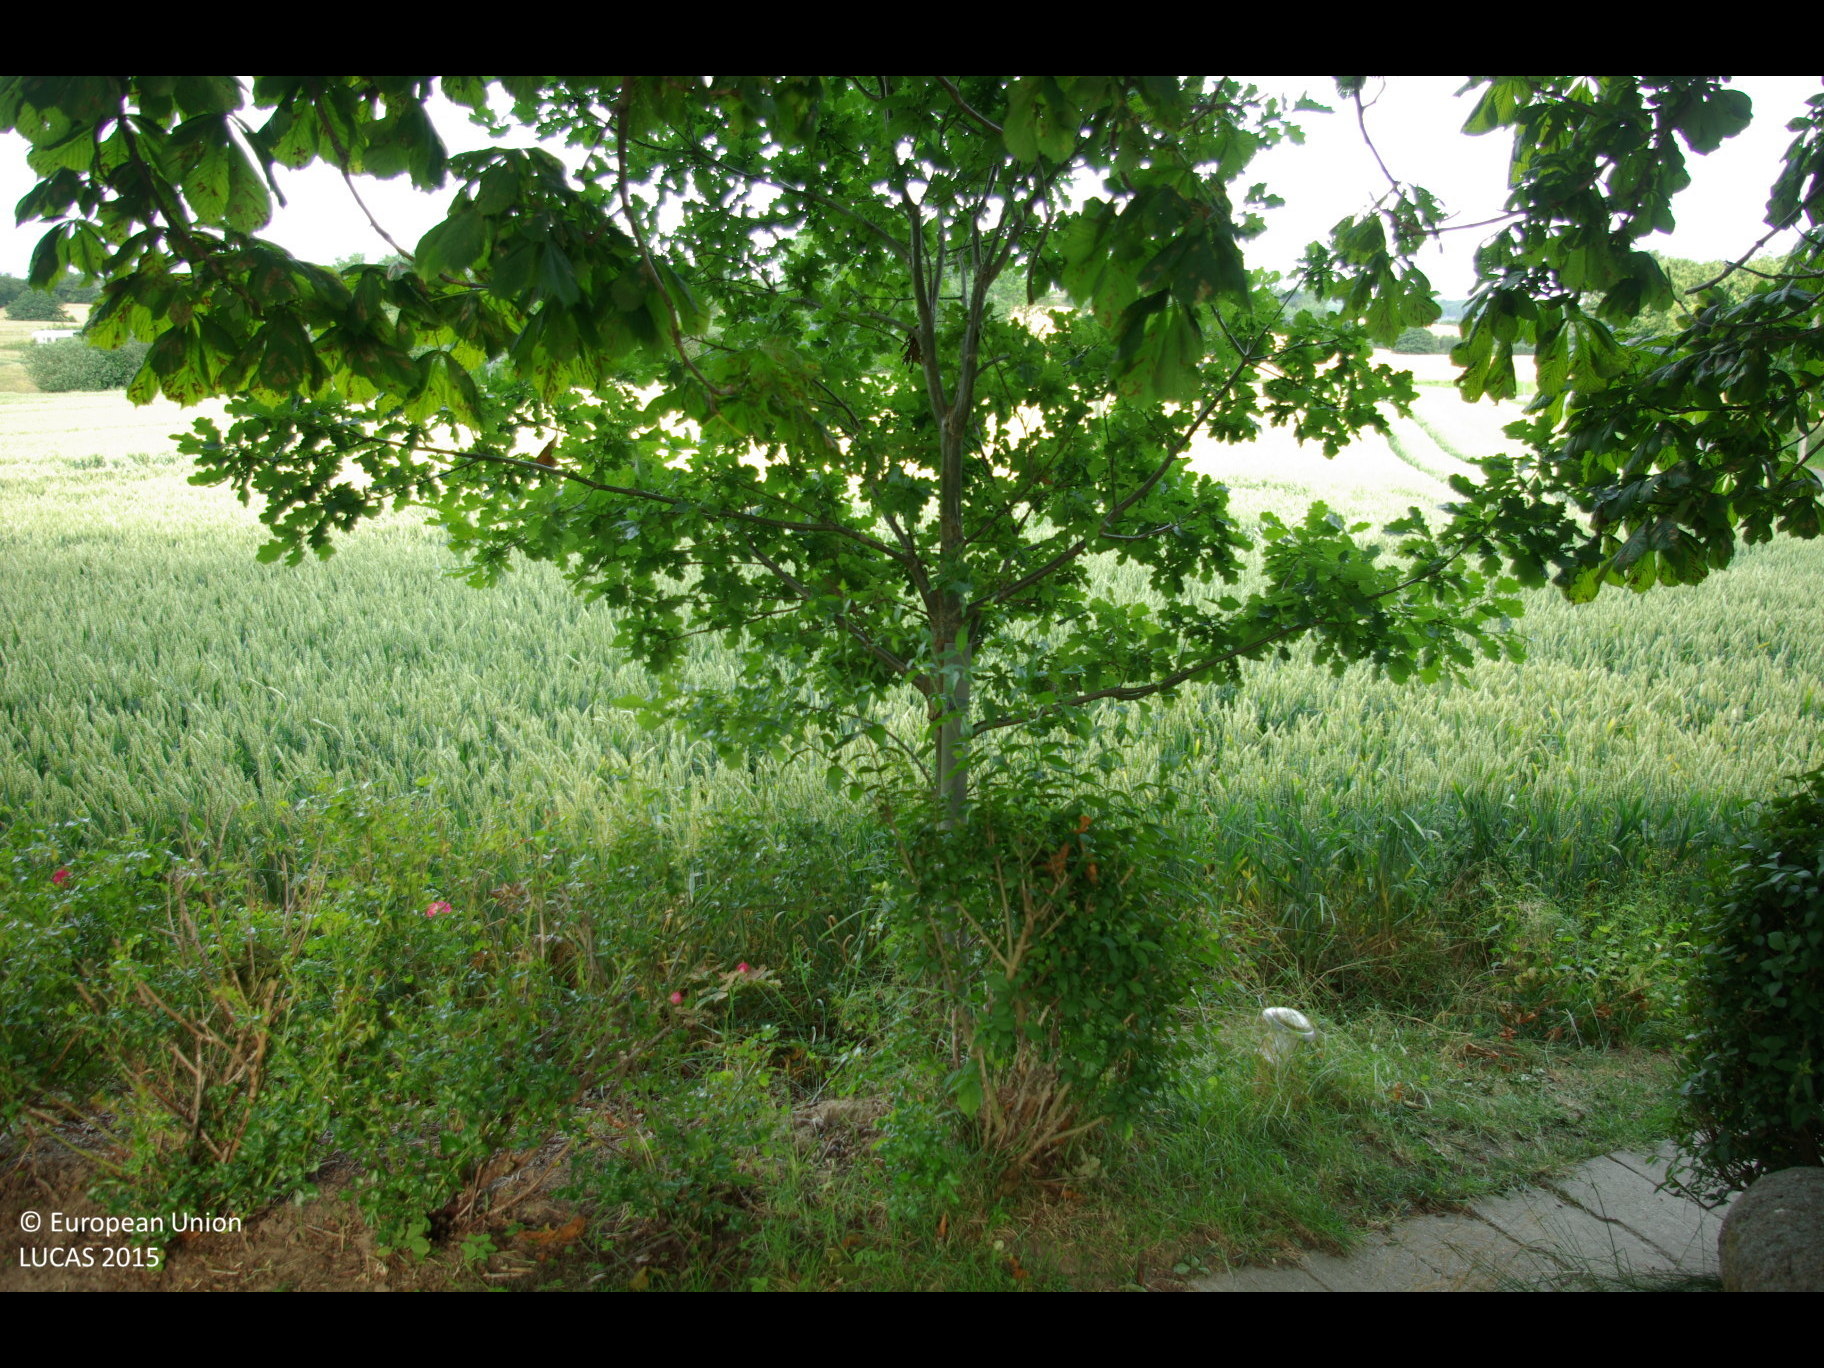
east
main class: Woodland
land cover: Broadleaved woodland
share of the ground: 50 - 75 %
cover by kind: broadleaved forest trees 50 %, herbaceous plants 50 %
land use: Residential
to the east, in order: Broadleaved woodland; Grassland without tree/shrub cover; Managed hedges; Single bushes/trees; Common wheat; Broadleaved woodland; Grass margins; Paved roads, cycling and walking lanes; Grass margins; Ditches and canals; Broadleaved woodland; Electric lines; Barley
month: July
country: DE
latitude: 54.6779
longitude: 9.9225
